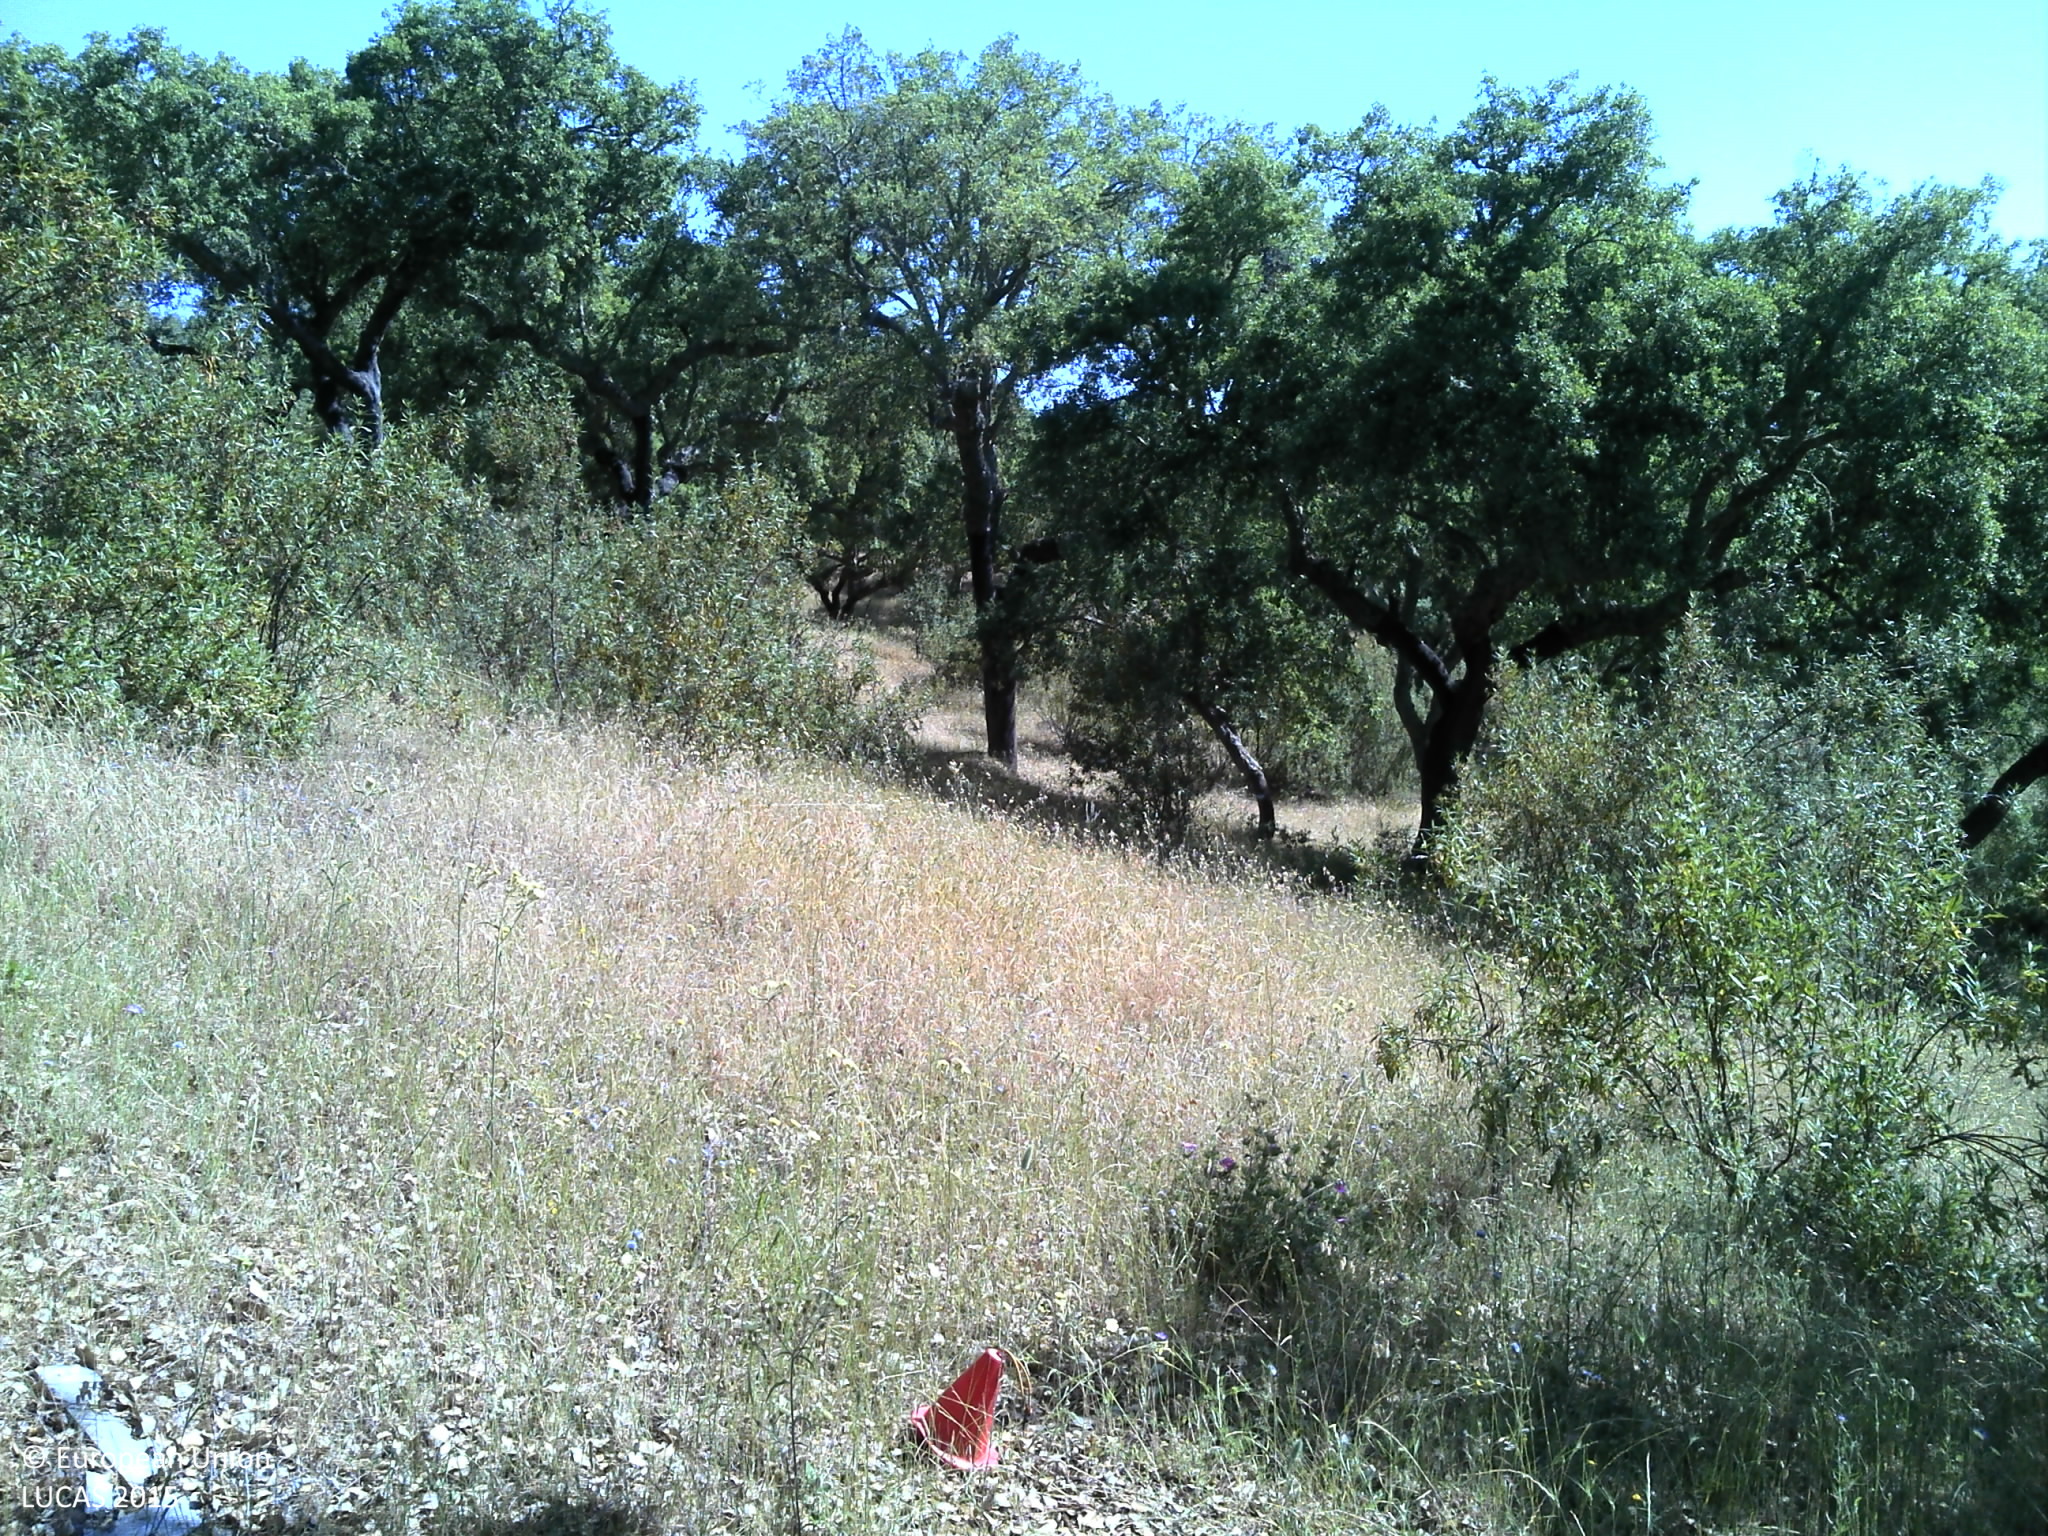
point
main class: Woodland
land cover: Broadleaved woodland
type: broadleaved evergreen forest
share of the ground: 25 - 50 %
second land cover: Shrubland without tree cover
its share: 25 - 50 %
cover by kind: broadleaved forest trees 40 %, herbaceous plants 25 %, unconsolidated bare surface 20 %, shrubs 15 %
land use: Forestry
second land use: Agriculture (excluding fallow land and kitchen gardens)
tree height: > 5 m
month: May
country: PT
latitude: 39.2201
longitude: -7.8766
